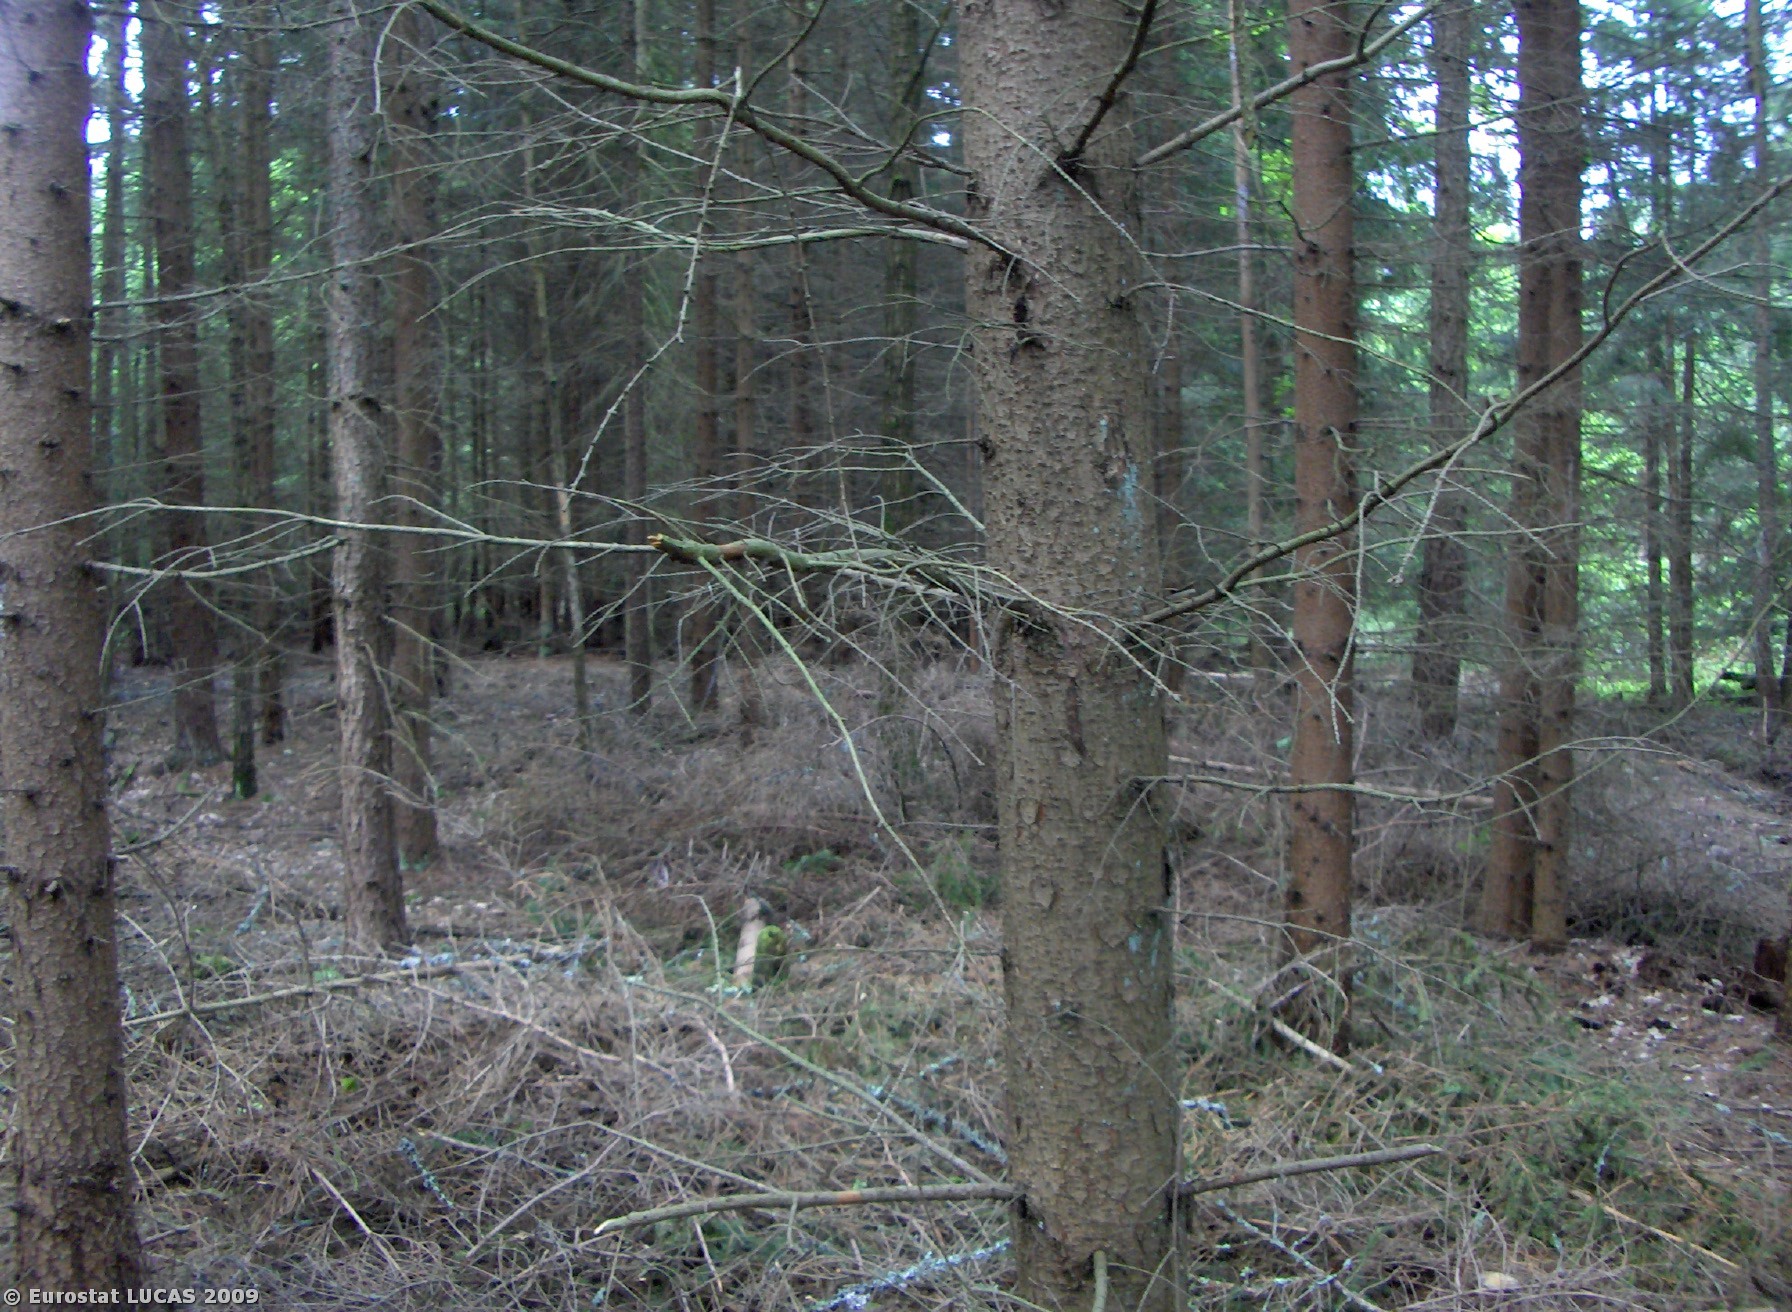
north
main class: Woodland
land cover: Coniferous woodland
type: hemiboreal forest and nemoral coniferous forest and mixed broadleaved-coniferous forest
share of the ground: > 75 %
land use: Forestry
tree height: > 5 m
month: May
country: CZ
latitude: 49.2278
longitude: 14.5741
